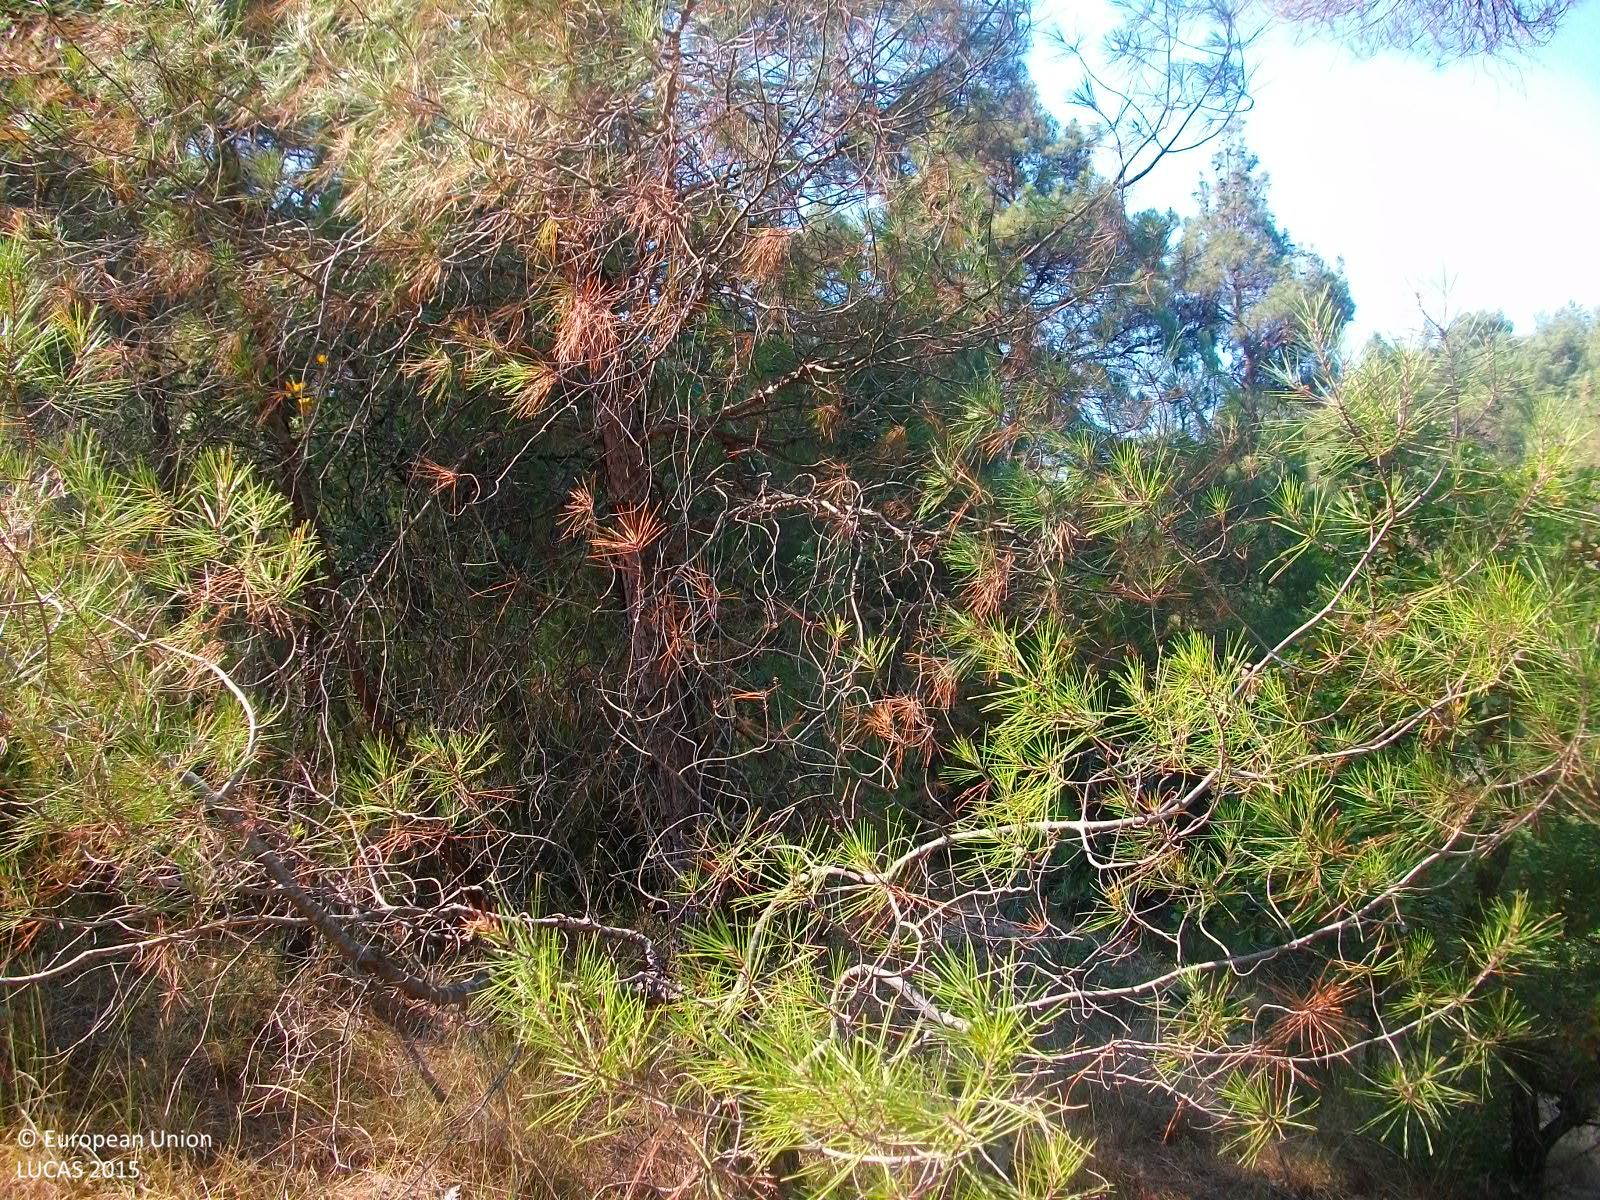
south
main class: Woodland
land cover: Pine dominated coniferous woodland
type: coniferous forest of the mediterranean region
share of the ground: > 75 %
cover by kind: coniferous forest trees 90 %, shrubs 5 %, herbaceous plants 5 %
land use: Forestry
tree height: > 5 m
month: July
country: GR
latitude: 41.0969
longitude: 26.2232
